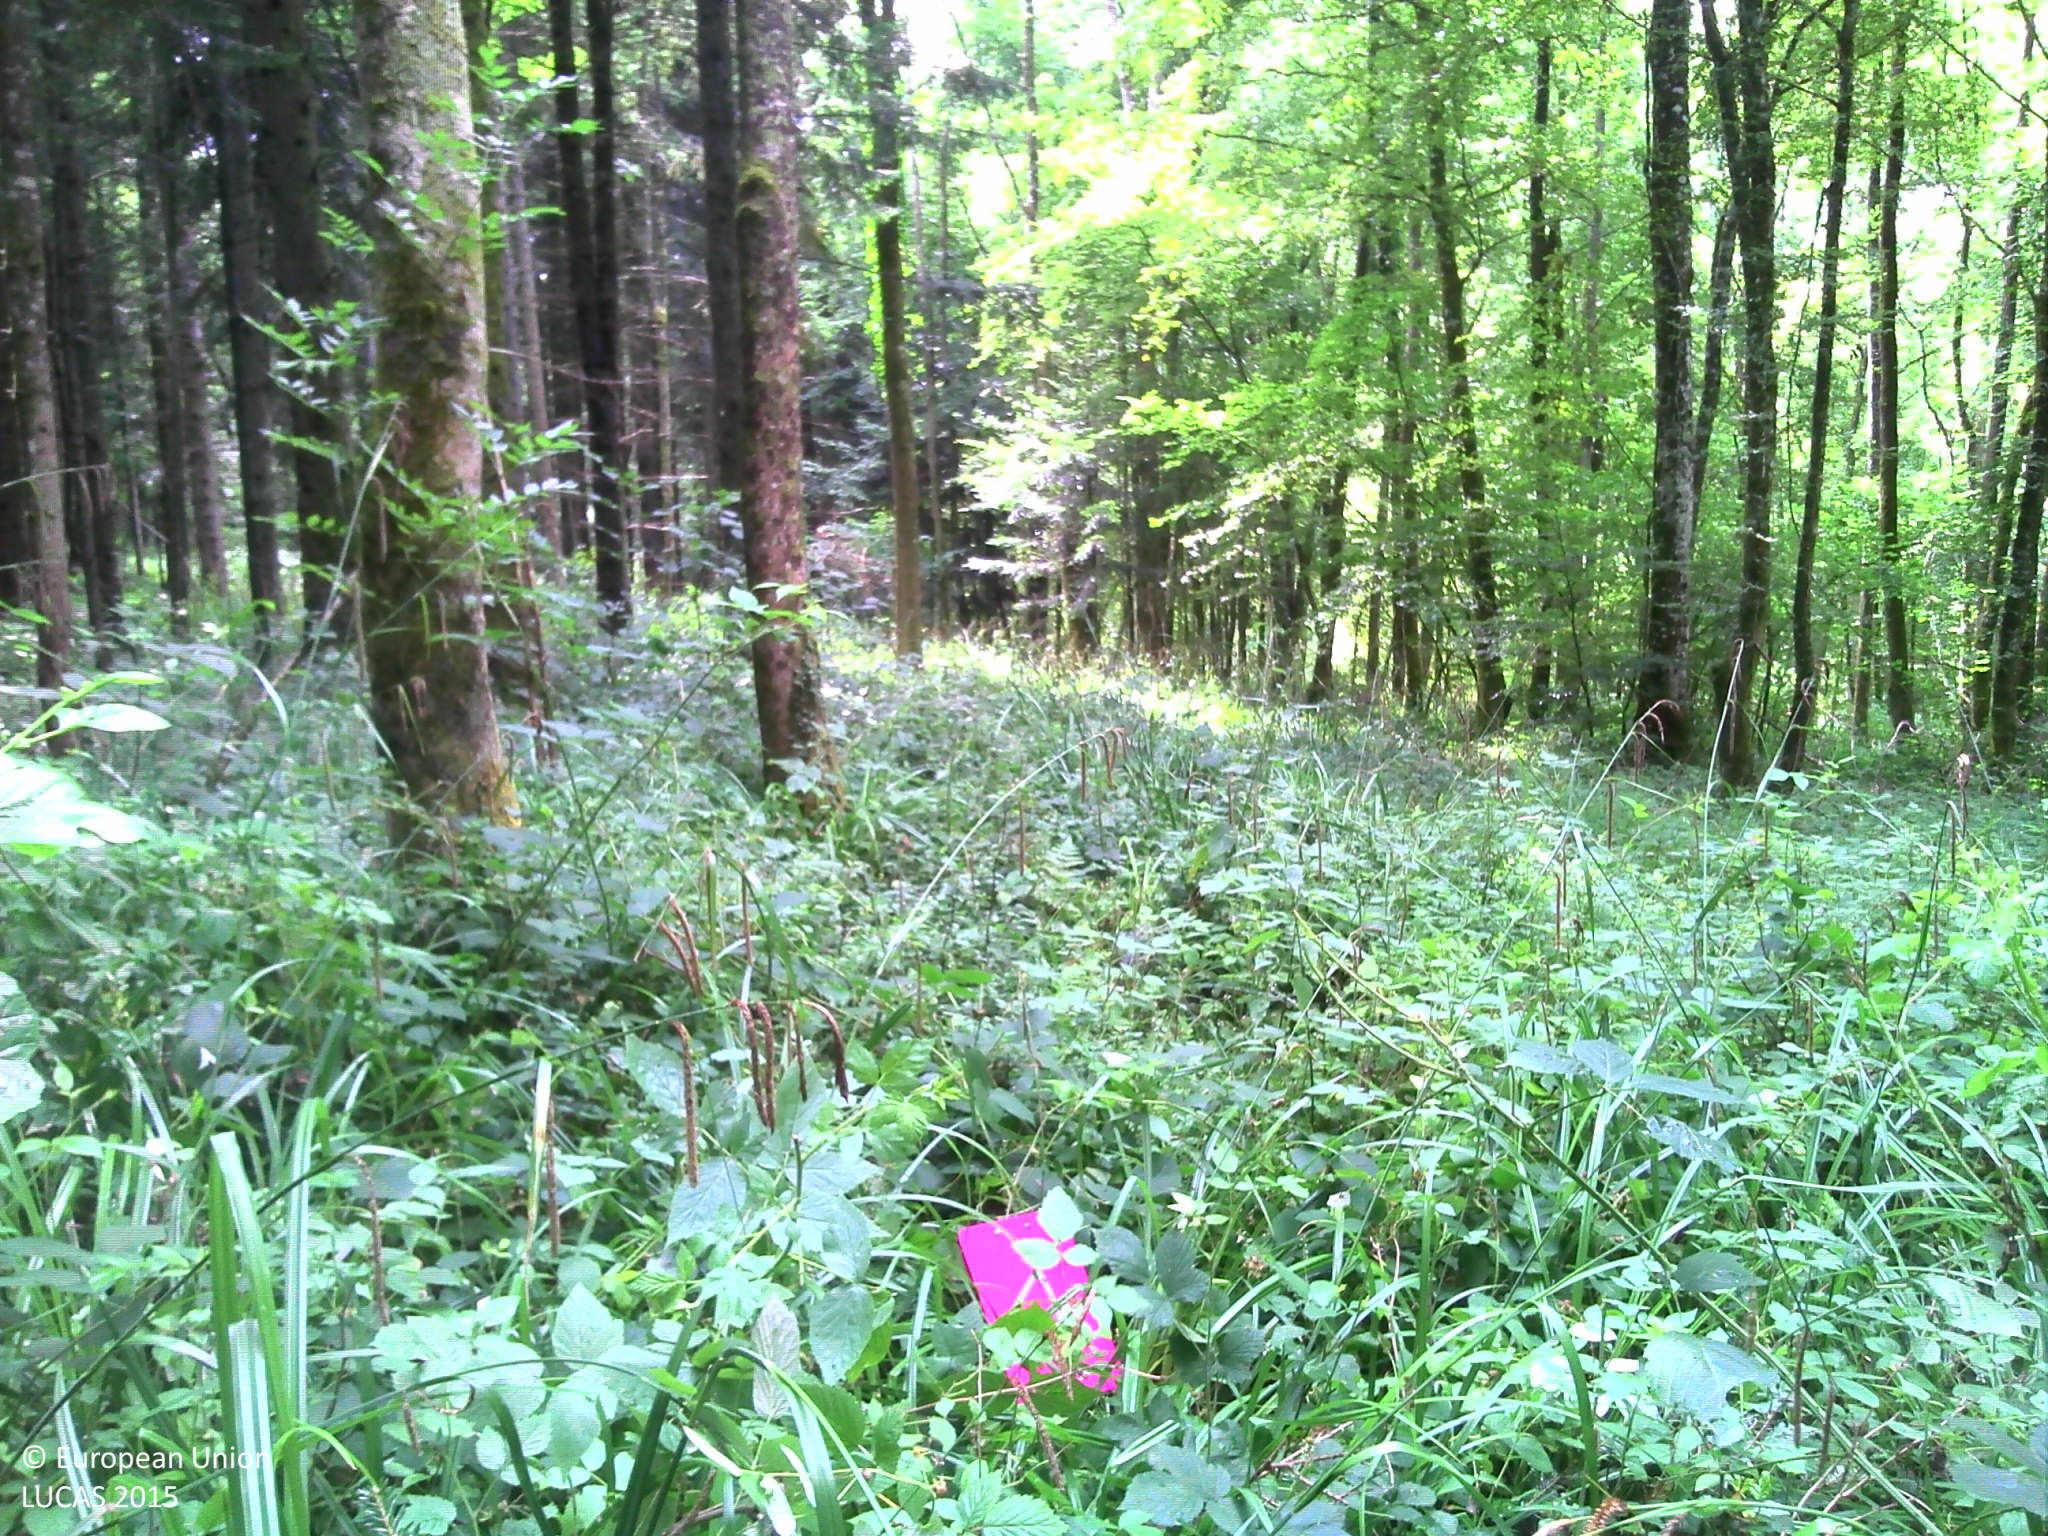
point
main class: Woodland
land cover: Broadleaved woodland
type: mesophytic deciduous forest
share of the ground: > 75 %
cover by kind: broadleaved forest trees 95 %, herbaceous plants 5 %
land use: Forestry
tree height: > 5 m
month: July
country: FR
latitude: 49.1781
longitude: 5.1007
